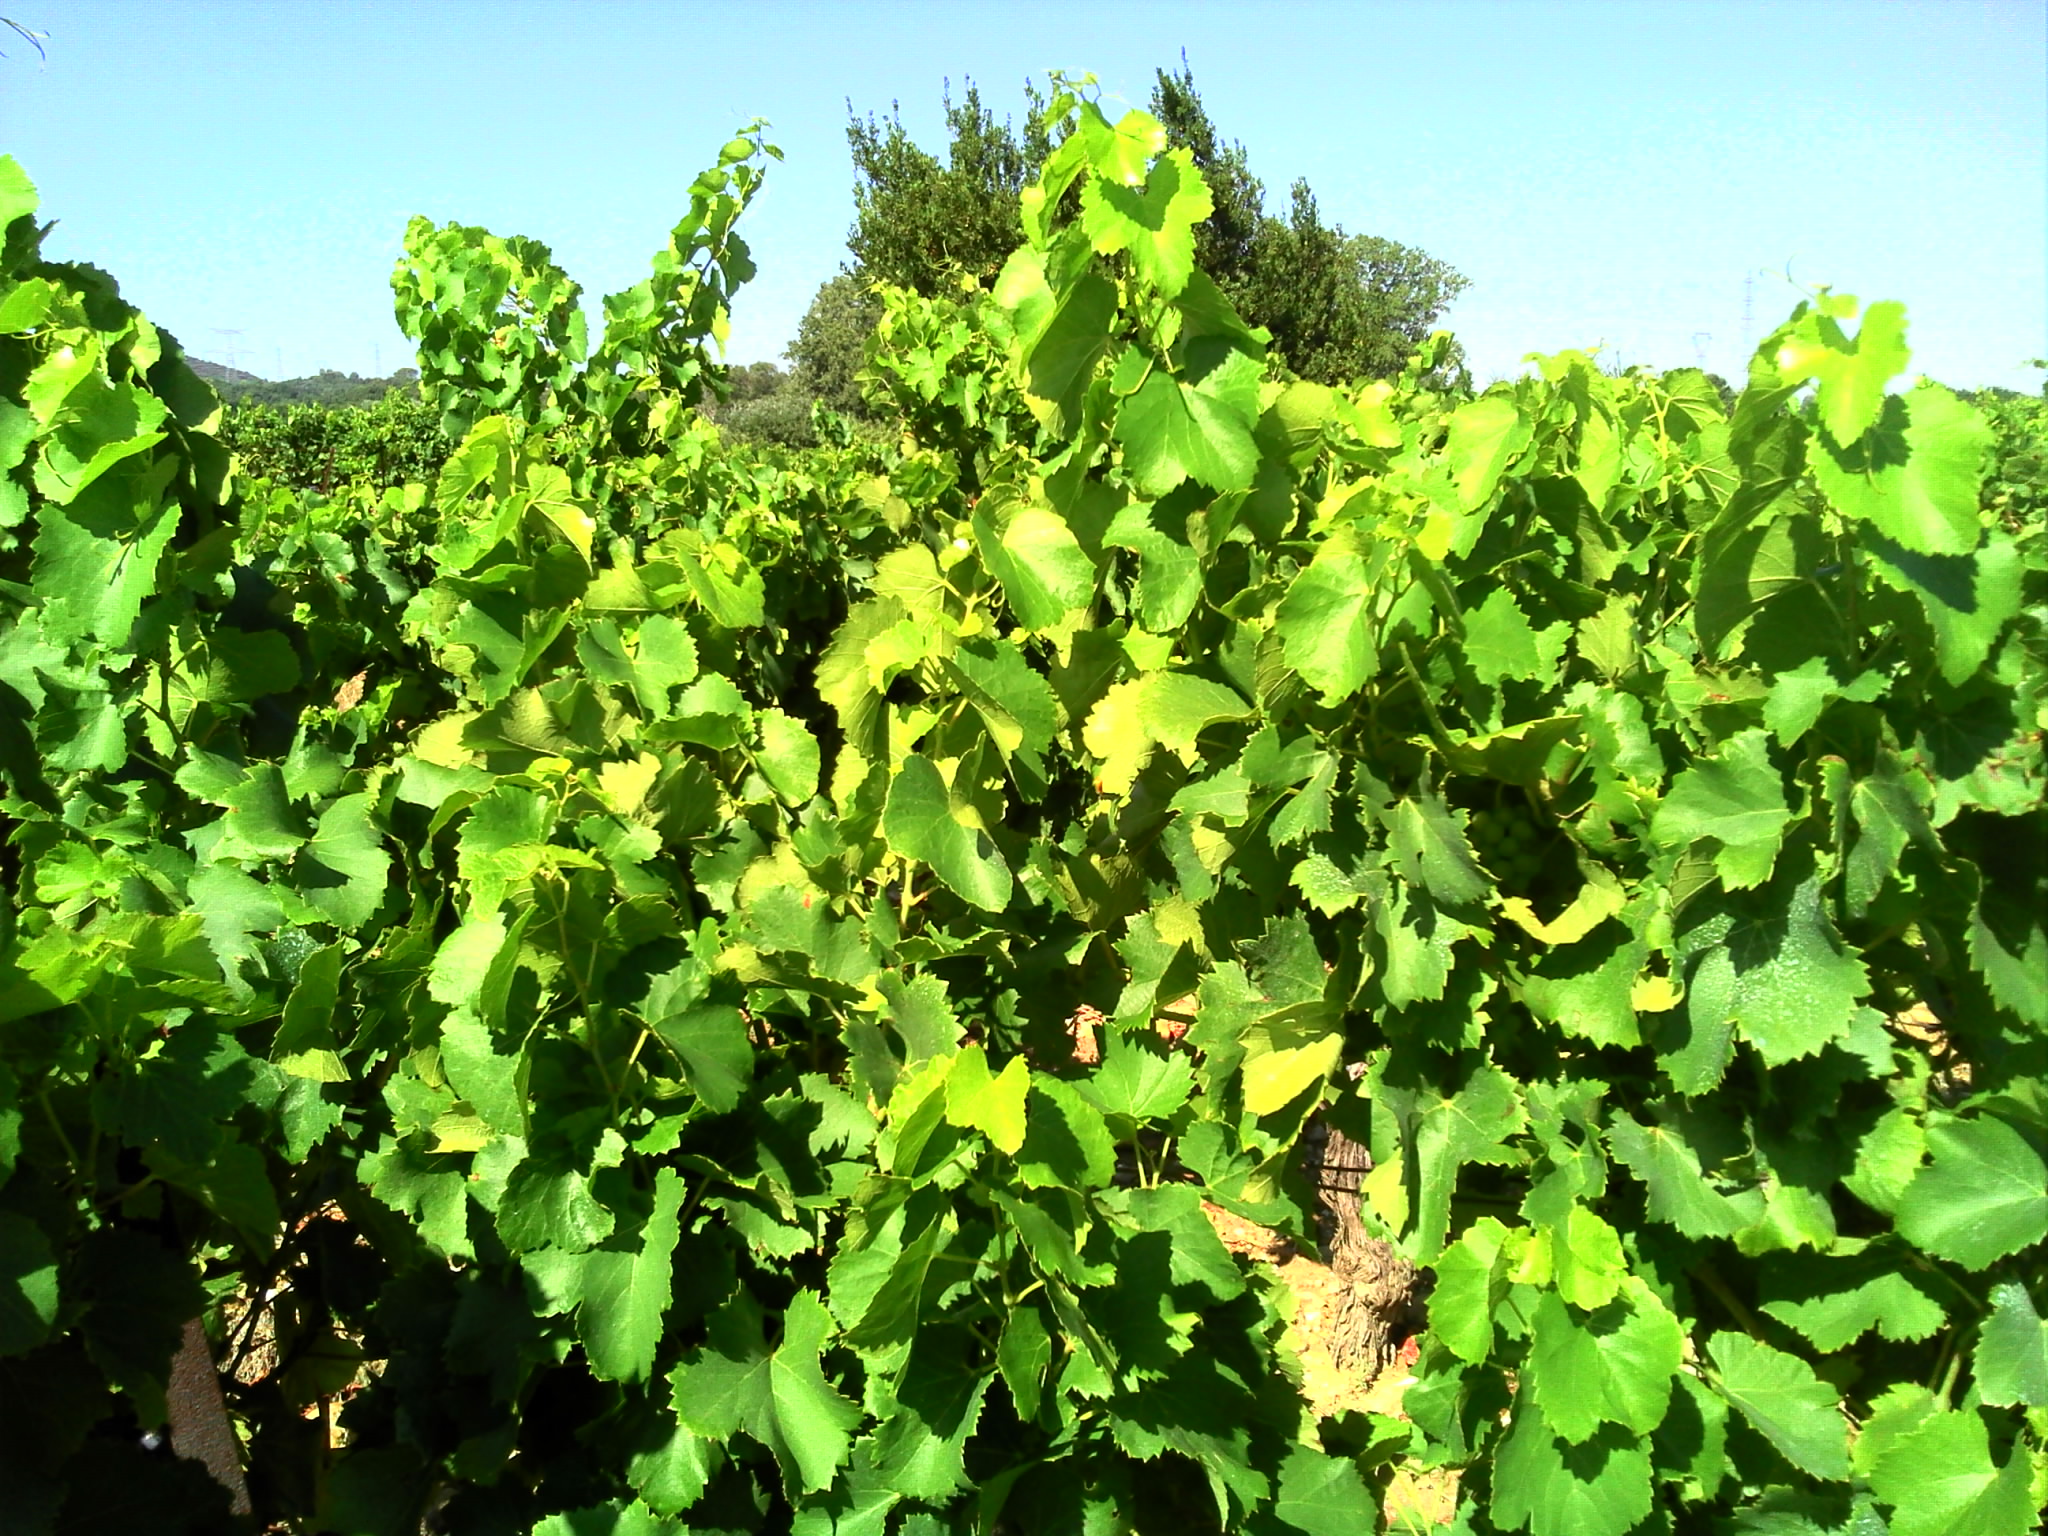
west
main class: Cropland
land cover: Vineyards
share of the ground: 25 - 50 %
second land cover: Other bare soil
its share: > 75 %
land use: Agriculture (excluding fallow land and kitchen gardens)
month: August
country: FR
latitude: 44.0706
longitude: 4.7017
